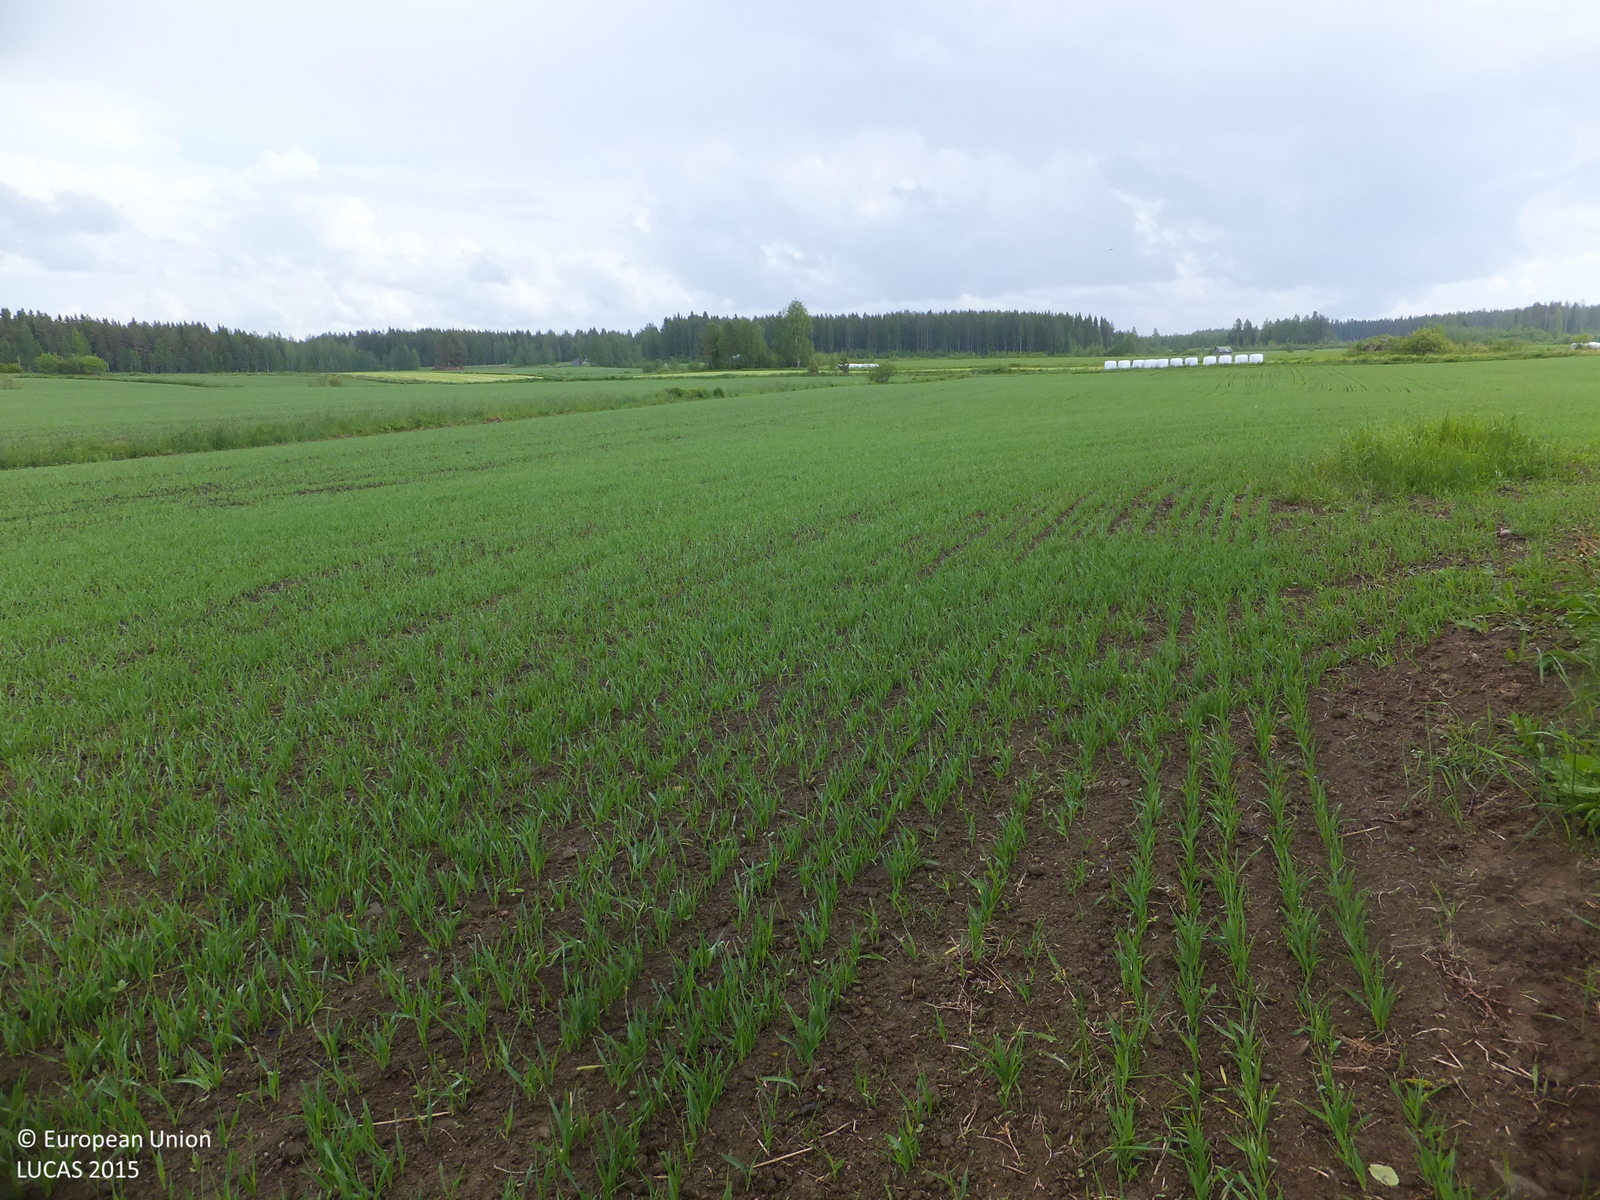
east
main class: Cropland
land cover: Barley
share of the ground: > 75 %
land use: Agriculture (excluding fallow land and kitchen gardens)
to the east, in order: Barley; Grass margins; Ditches and canals; Grass margins; Barley; Grass margins; Ditches and canals; Grass margins; Barley; Grass margins; Ditches and canals; Grass margins; Temporary grasslands
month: June
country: FI
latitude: 63.6165
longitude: 25.0769
